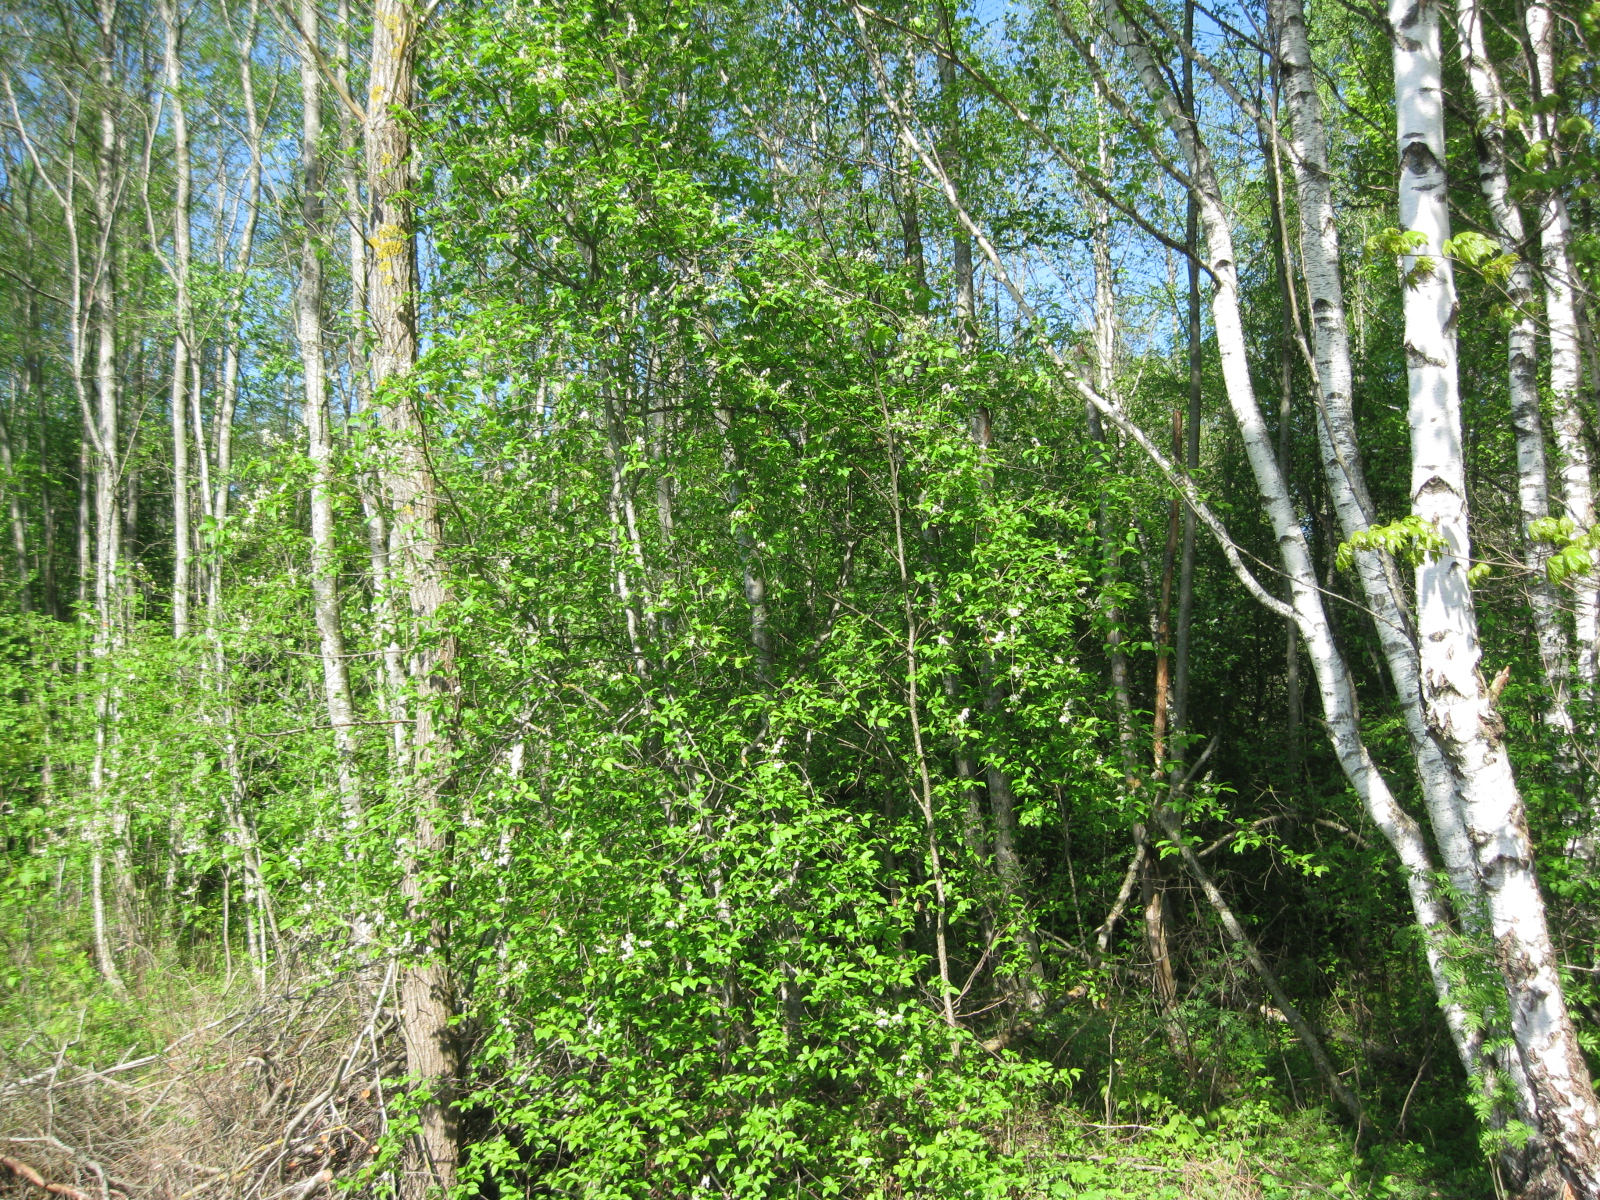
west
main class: Grassland
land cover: Spontaneously vegetated surfaces
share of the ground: 50 - 75 %
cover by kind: herbaceous plants 60 %, unconsolidated bare surface 40 %
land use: Agriculture (excluding fallow land and kitchen gardens)
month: May
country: LT
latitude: 56.0234
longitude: 24.9168
